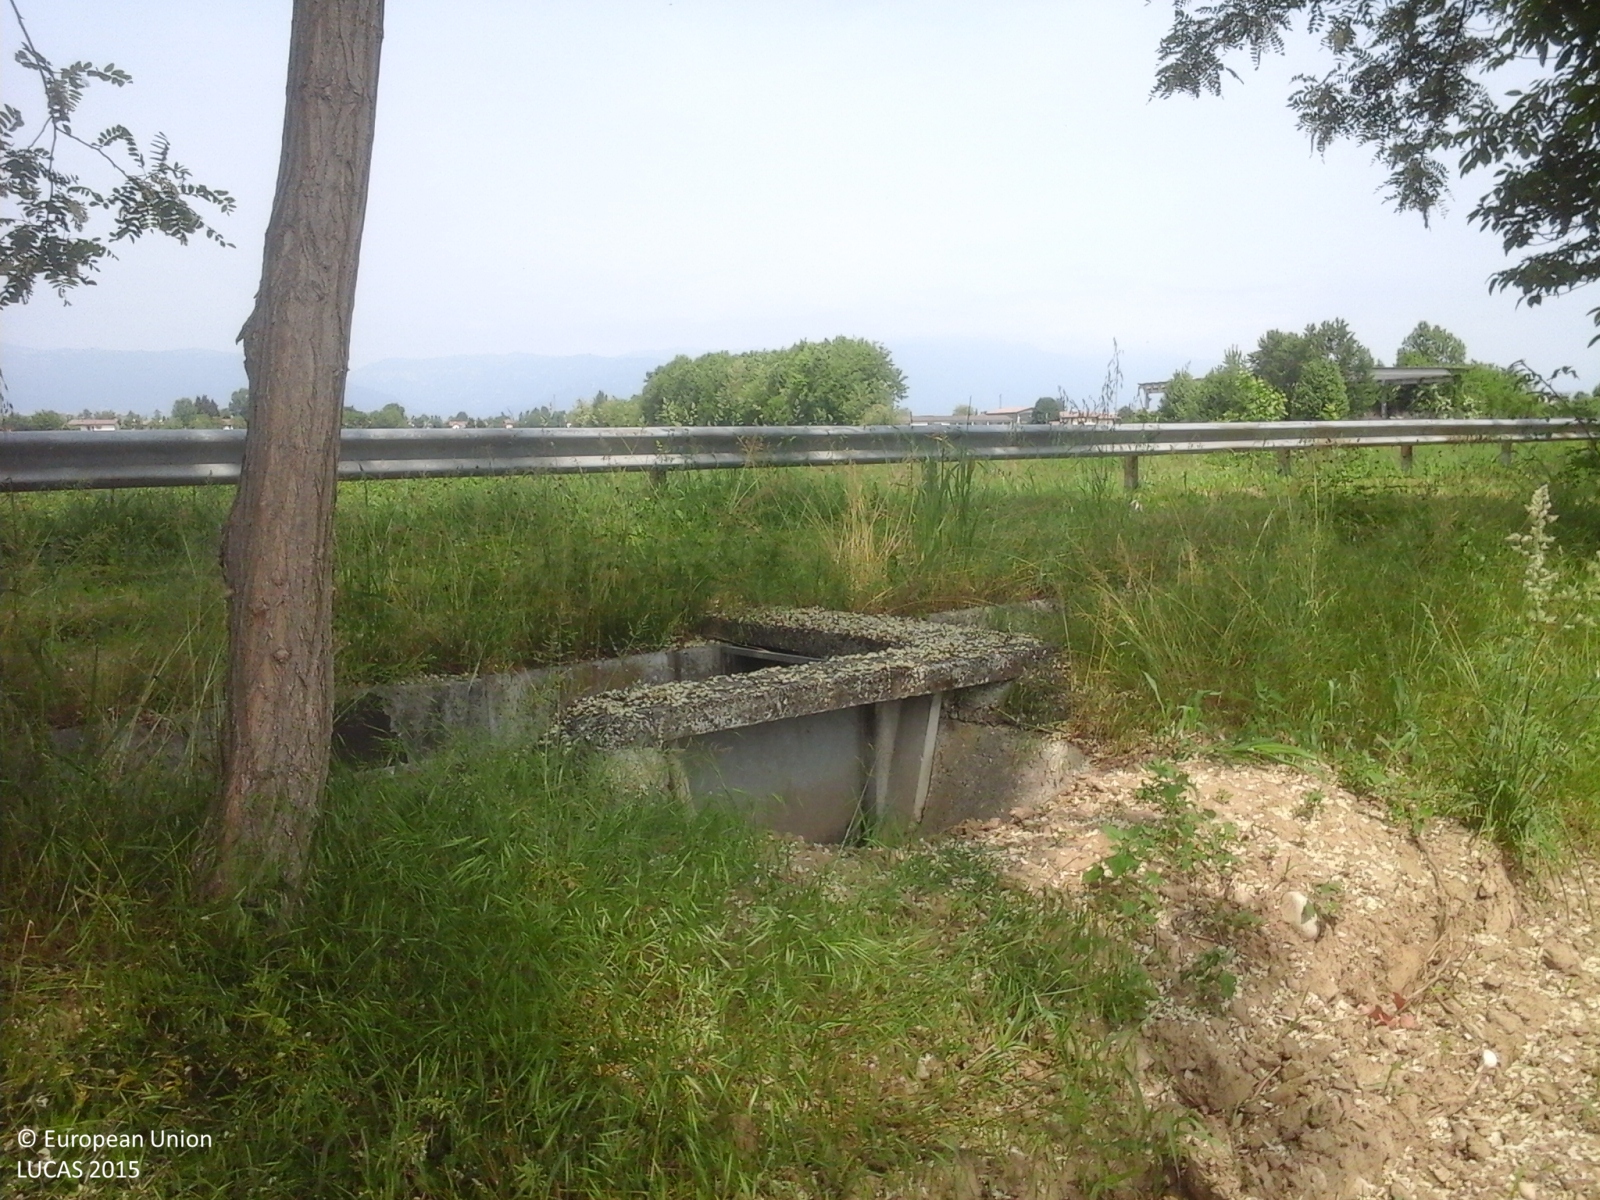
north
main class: Cropland
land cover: Maize
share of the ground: 10 - 25 %
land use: Agriculture (excluding fallow land and kitchen gardens)
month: May
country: IT
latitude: 45.6521
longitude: 11.7553
